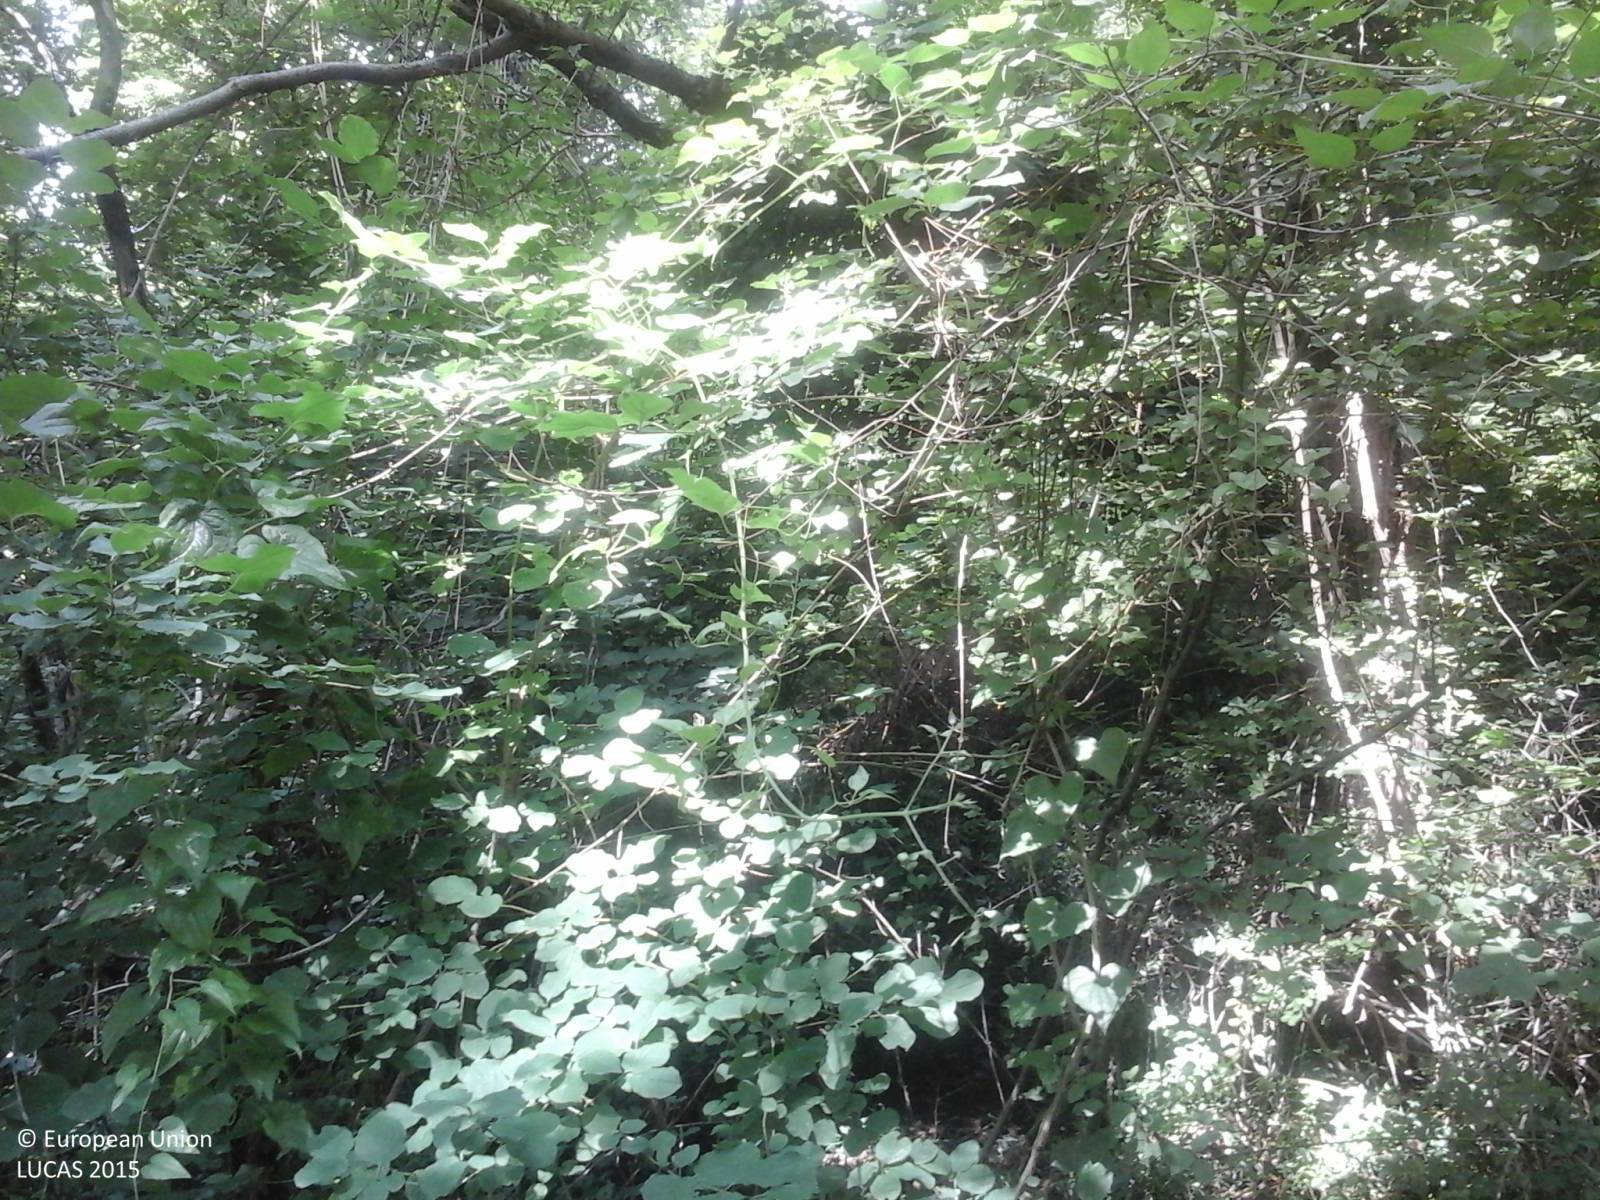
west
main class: Woodland
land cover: Broadleaved woodland
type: exotic forest
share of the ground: > 75 %
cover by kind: broadleaved forest trees 80 %, shrubs 20 %
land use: Forestry
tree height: > 5 m
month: June
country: IT
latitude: 46.0861
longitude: 12.5704
